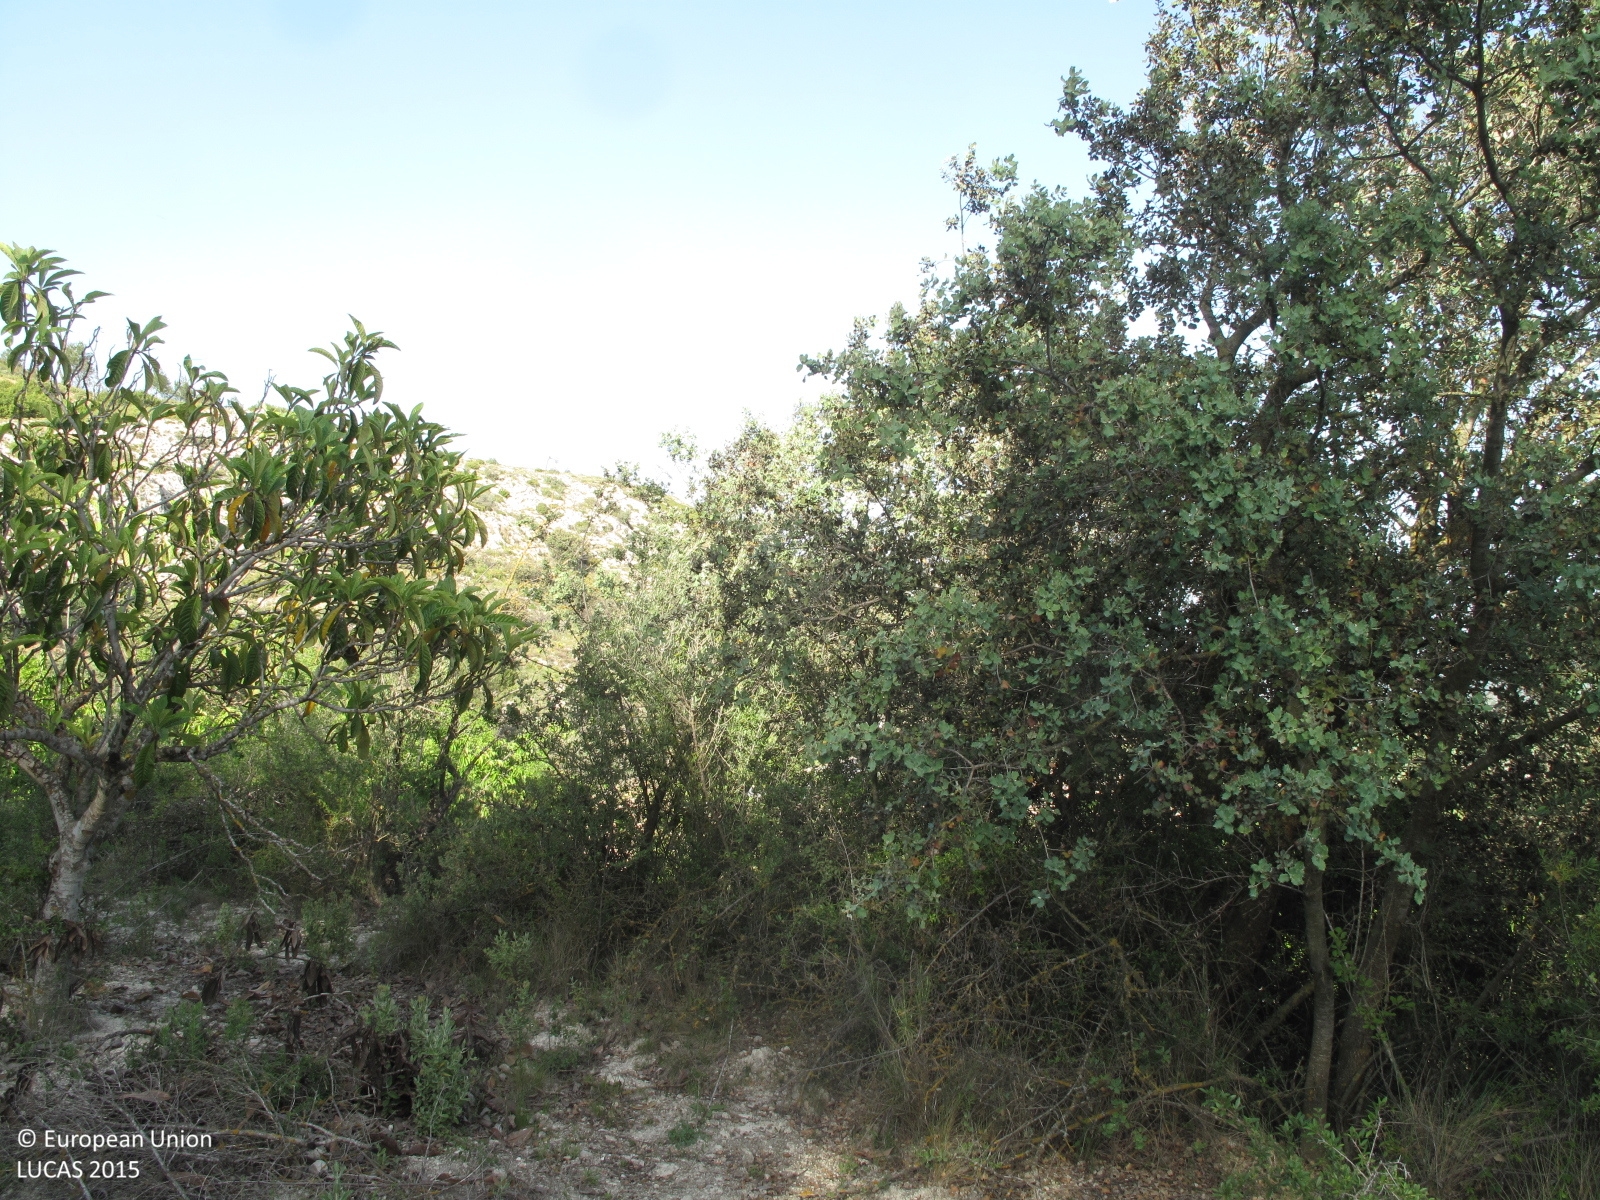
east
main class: Shrubland
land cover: Shrubland with sparse tree cover
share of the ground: 25 - 50 %
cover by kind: herbaceous plants 40 %, shrubs 35 %, consolidated bare surface 20 %, broadleaved forest trees 5 %
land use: Semi-natural and natural areas not in use
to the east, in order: Shrubland with sparse tree cover; Cherry fruit; Groves; Artificial constructions in urban areas; Tracks; Groves; Nuts trees; Shrubland with sparse tree cover
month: May
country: ES
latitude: 38.8030
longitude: -0.5499
